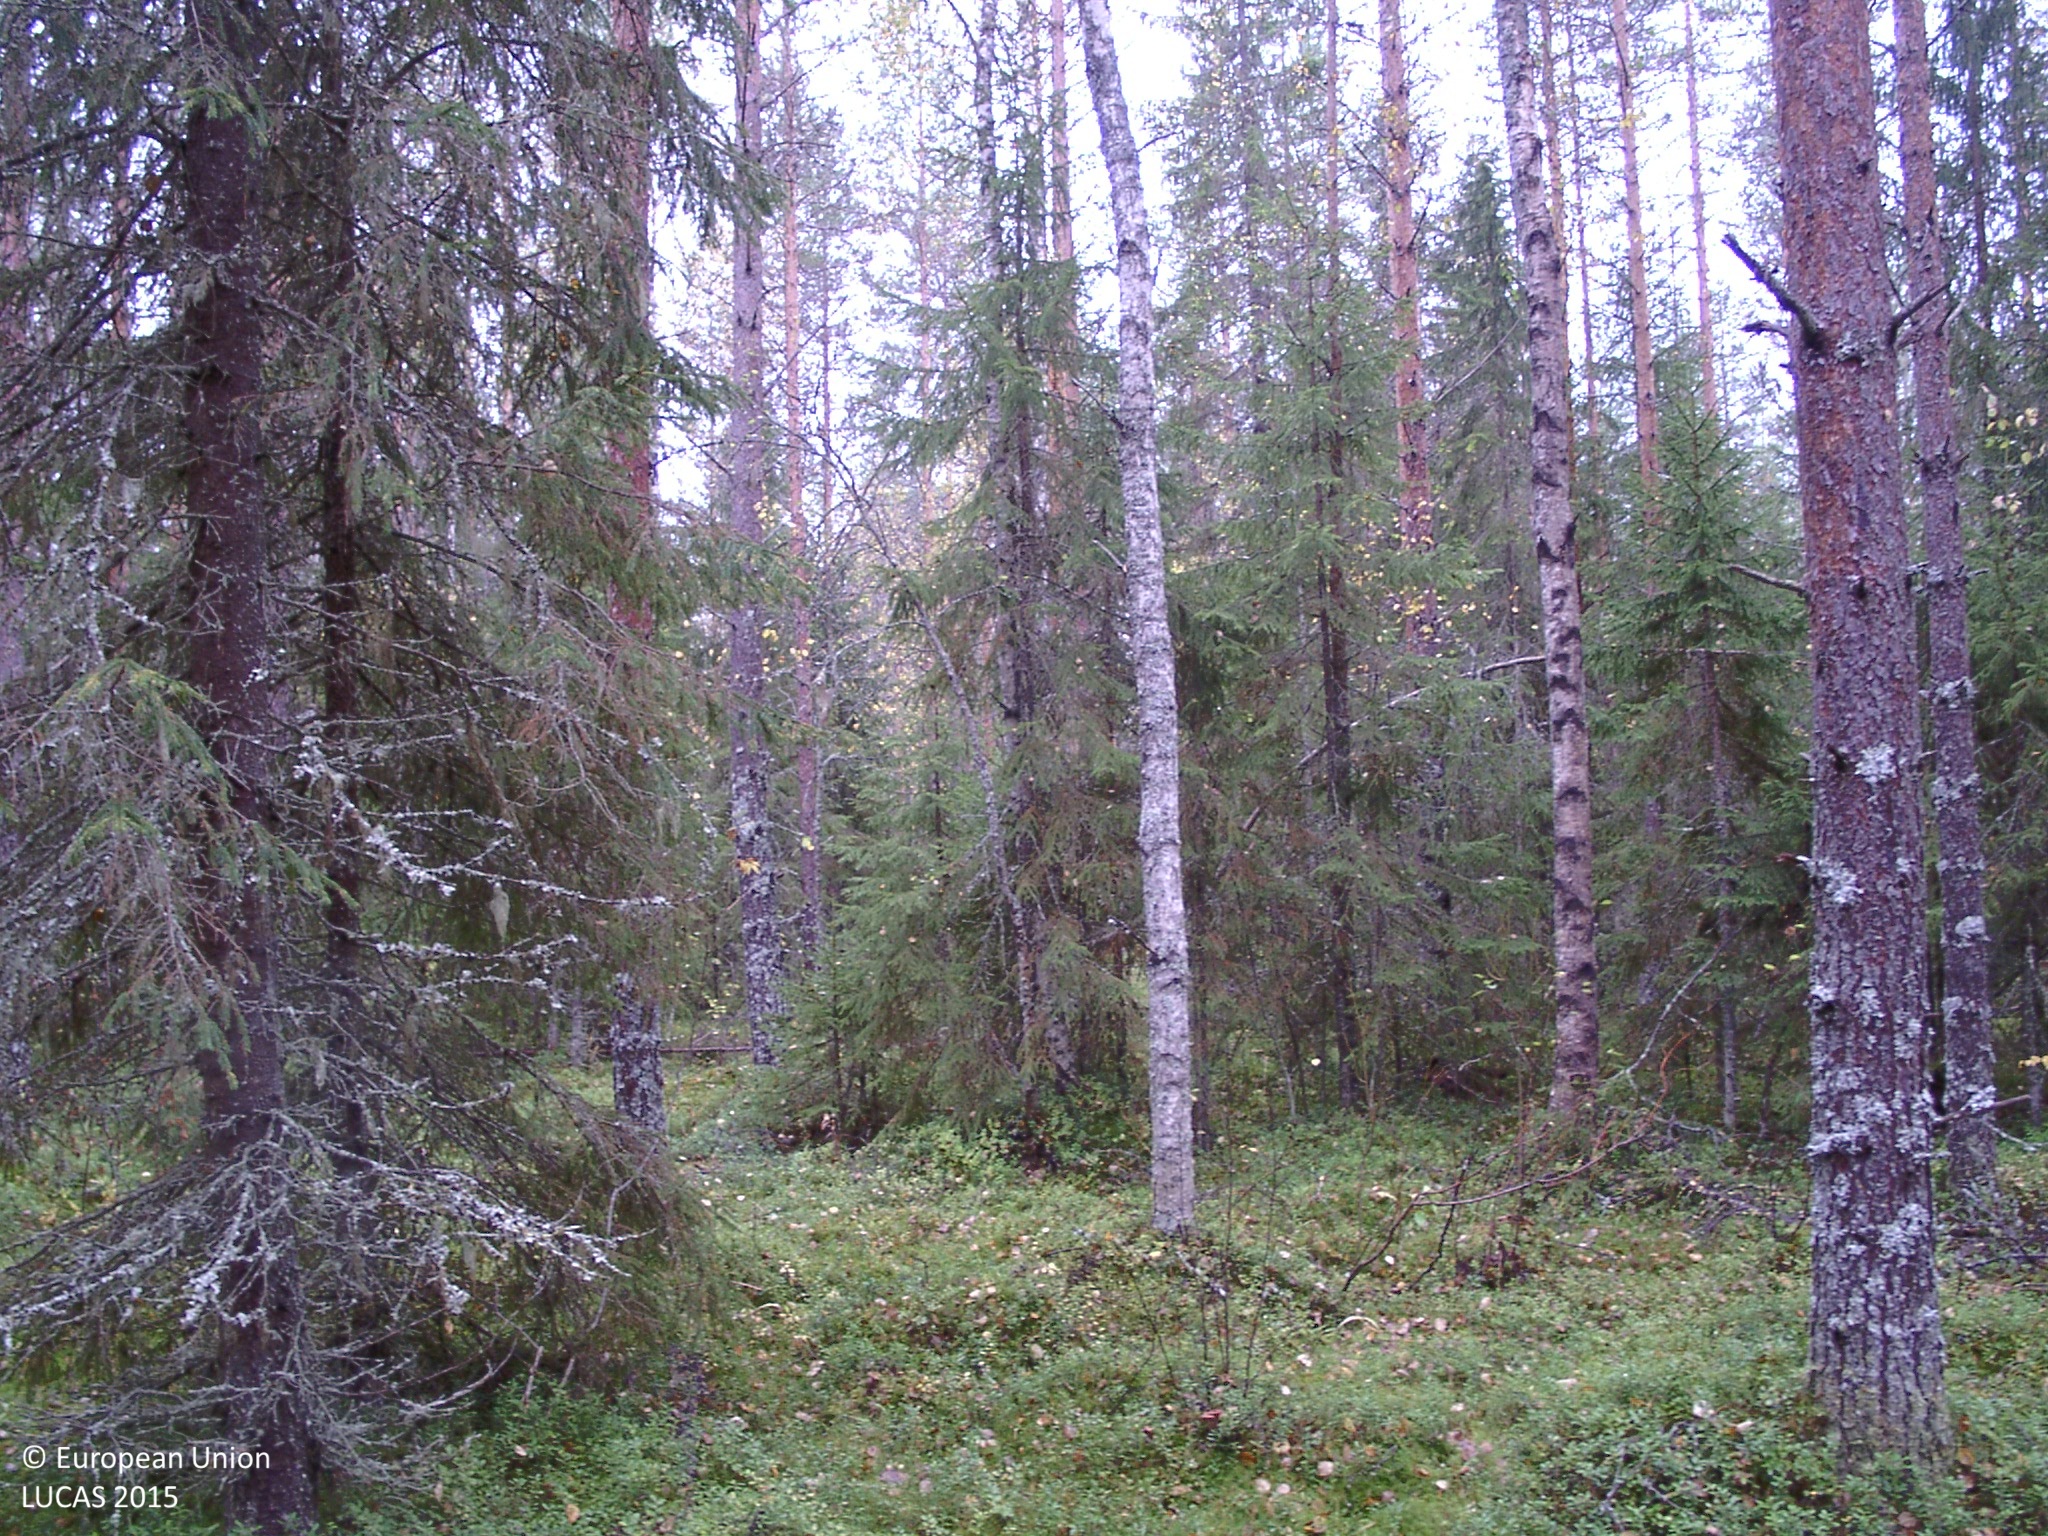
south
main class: Woodland
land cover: Other mixed woodland
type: boreal forest
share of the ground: 50 - 75 %
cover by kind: coniferous forest trees 40 %, shrubs 20 %, broadleaved forest trees 15 %, lichens and mosses 15 %, herbaceous plants 10 %
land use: Forestry
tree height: > 5 m
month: September
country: FI
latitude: 62.8335
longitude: 25.5200
